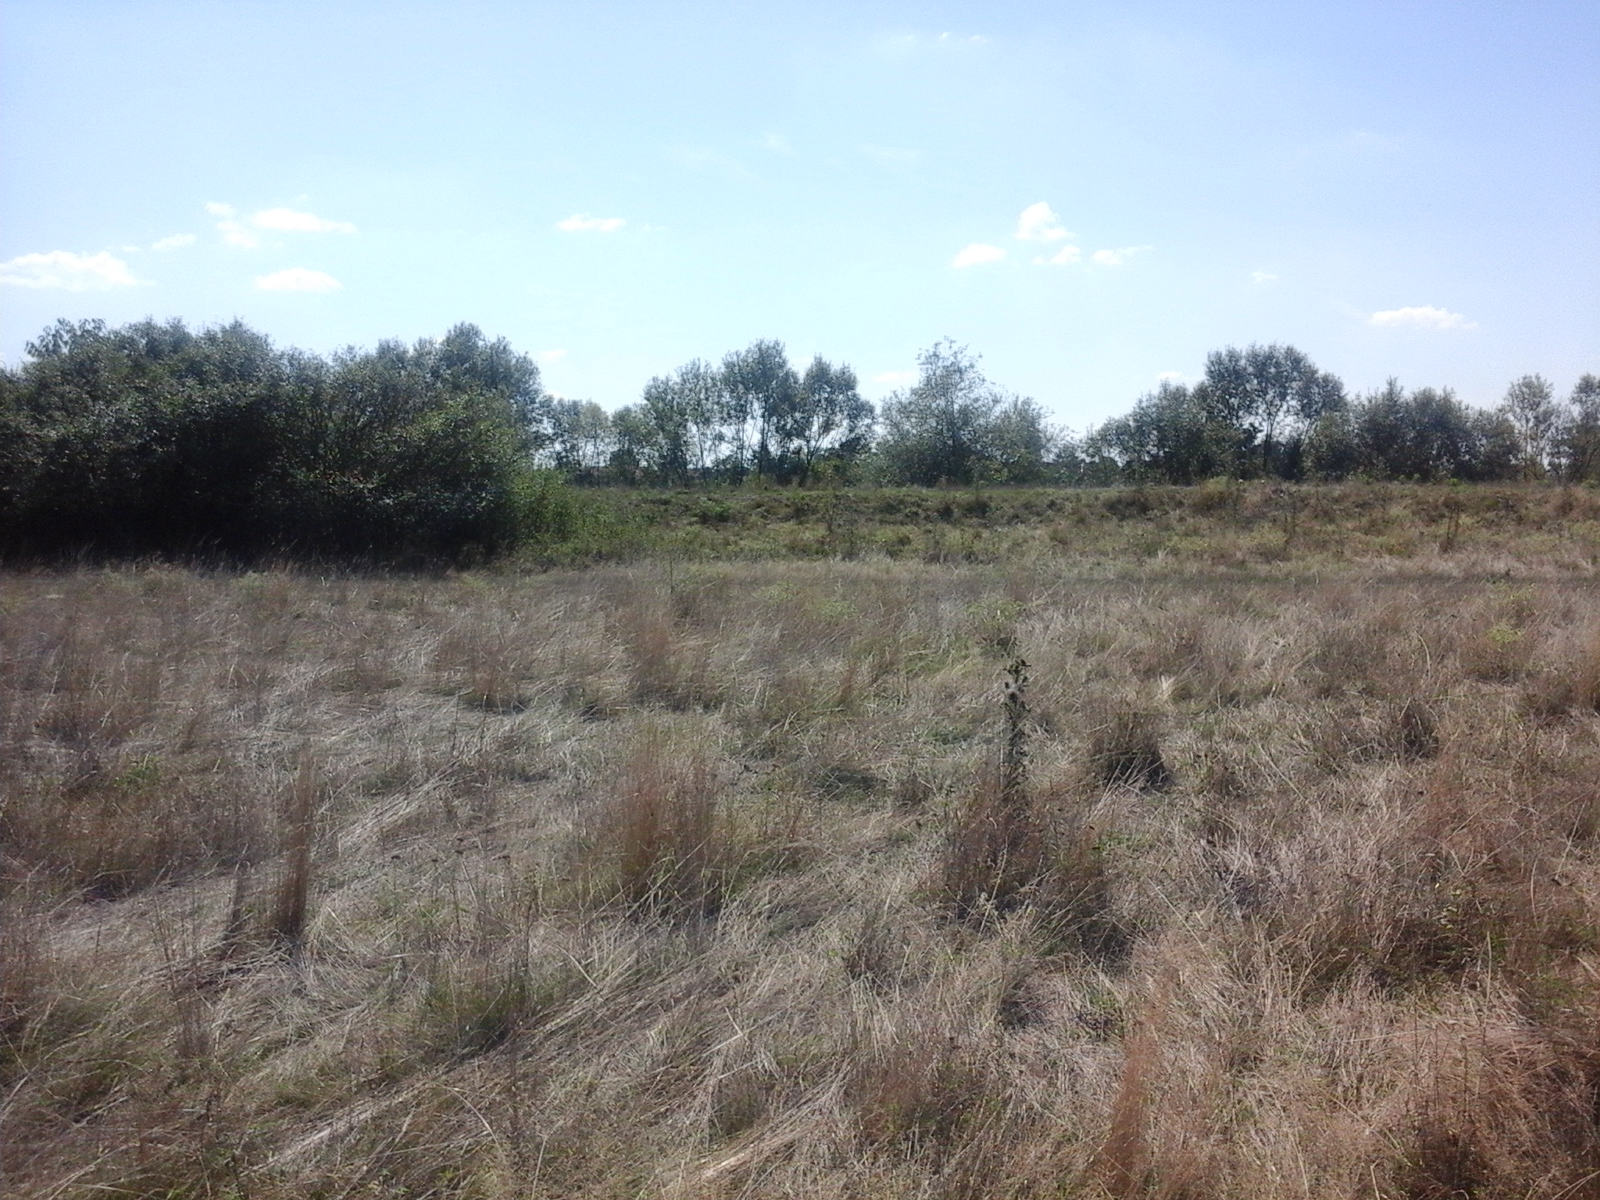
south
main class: Grassland
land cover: Spontaneously vegetated surfaces
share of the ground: > 75 %
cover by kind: herbaceous plants 100 %
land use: Agriculture (excluding fallow land and kitchen gardens)
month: August
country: RO
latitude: 45.6969
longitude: 21.7878
